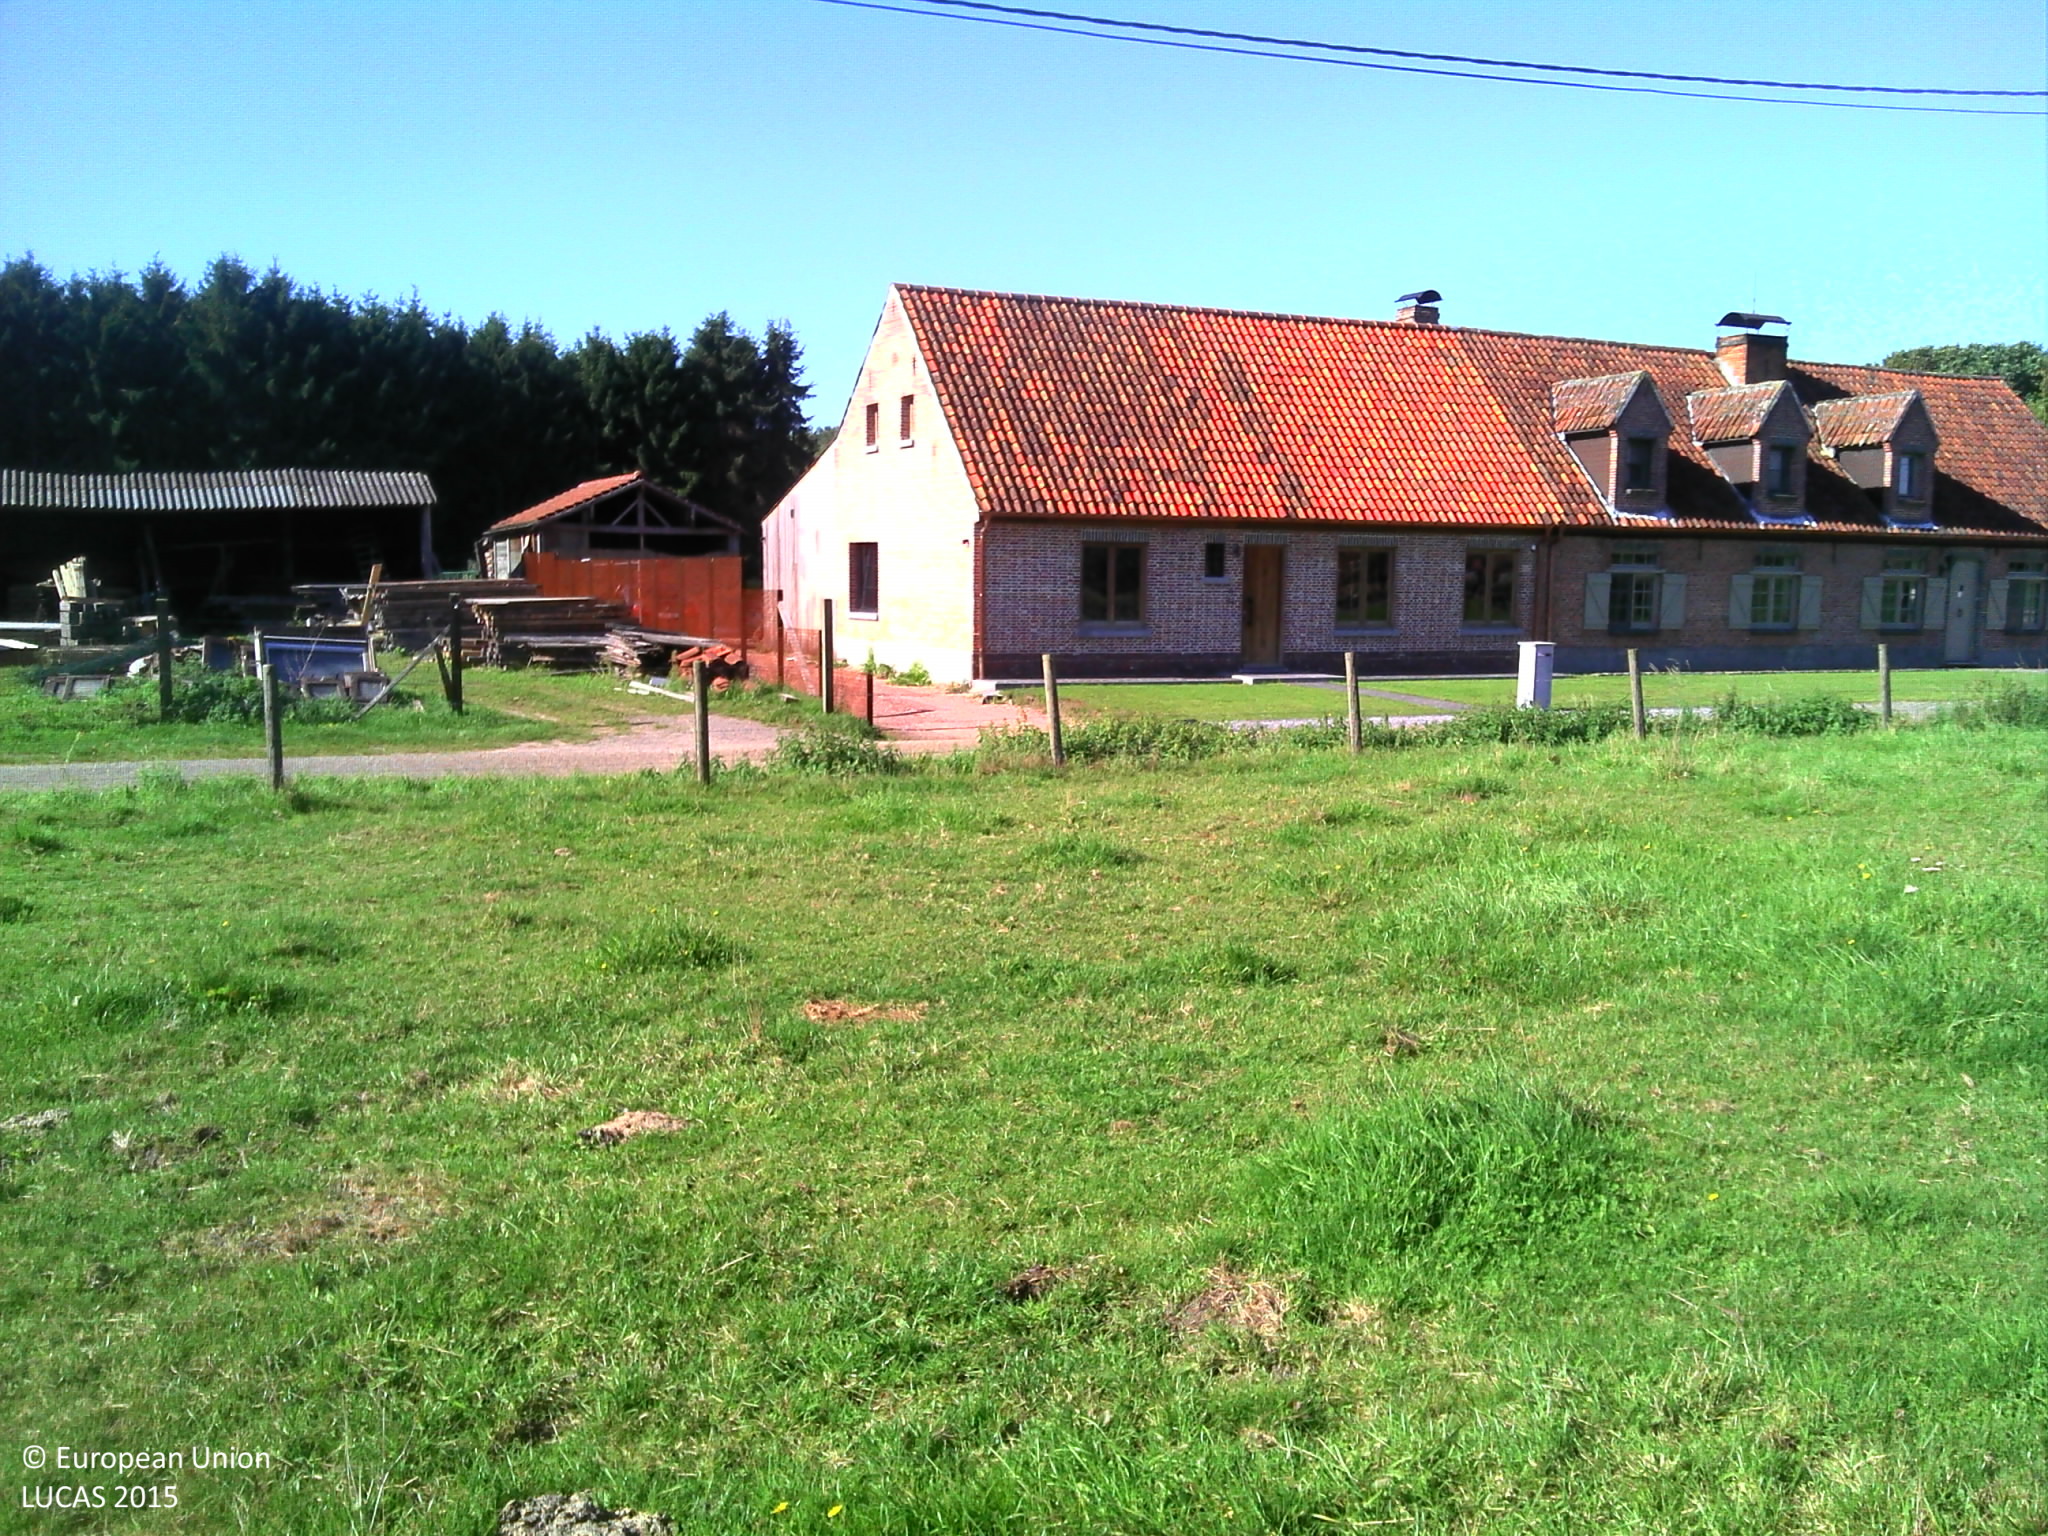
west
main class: Grassland
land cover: Grassland without tree/shrub cover
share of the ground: > 75 %
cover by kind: herbaceous plants 100 %
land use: Agriculture (excluding fallow land and kitchen gardens)
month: September
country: BE
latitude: 51.2546
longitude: 4.7953
